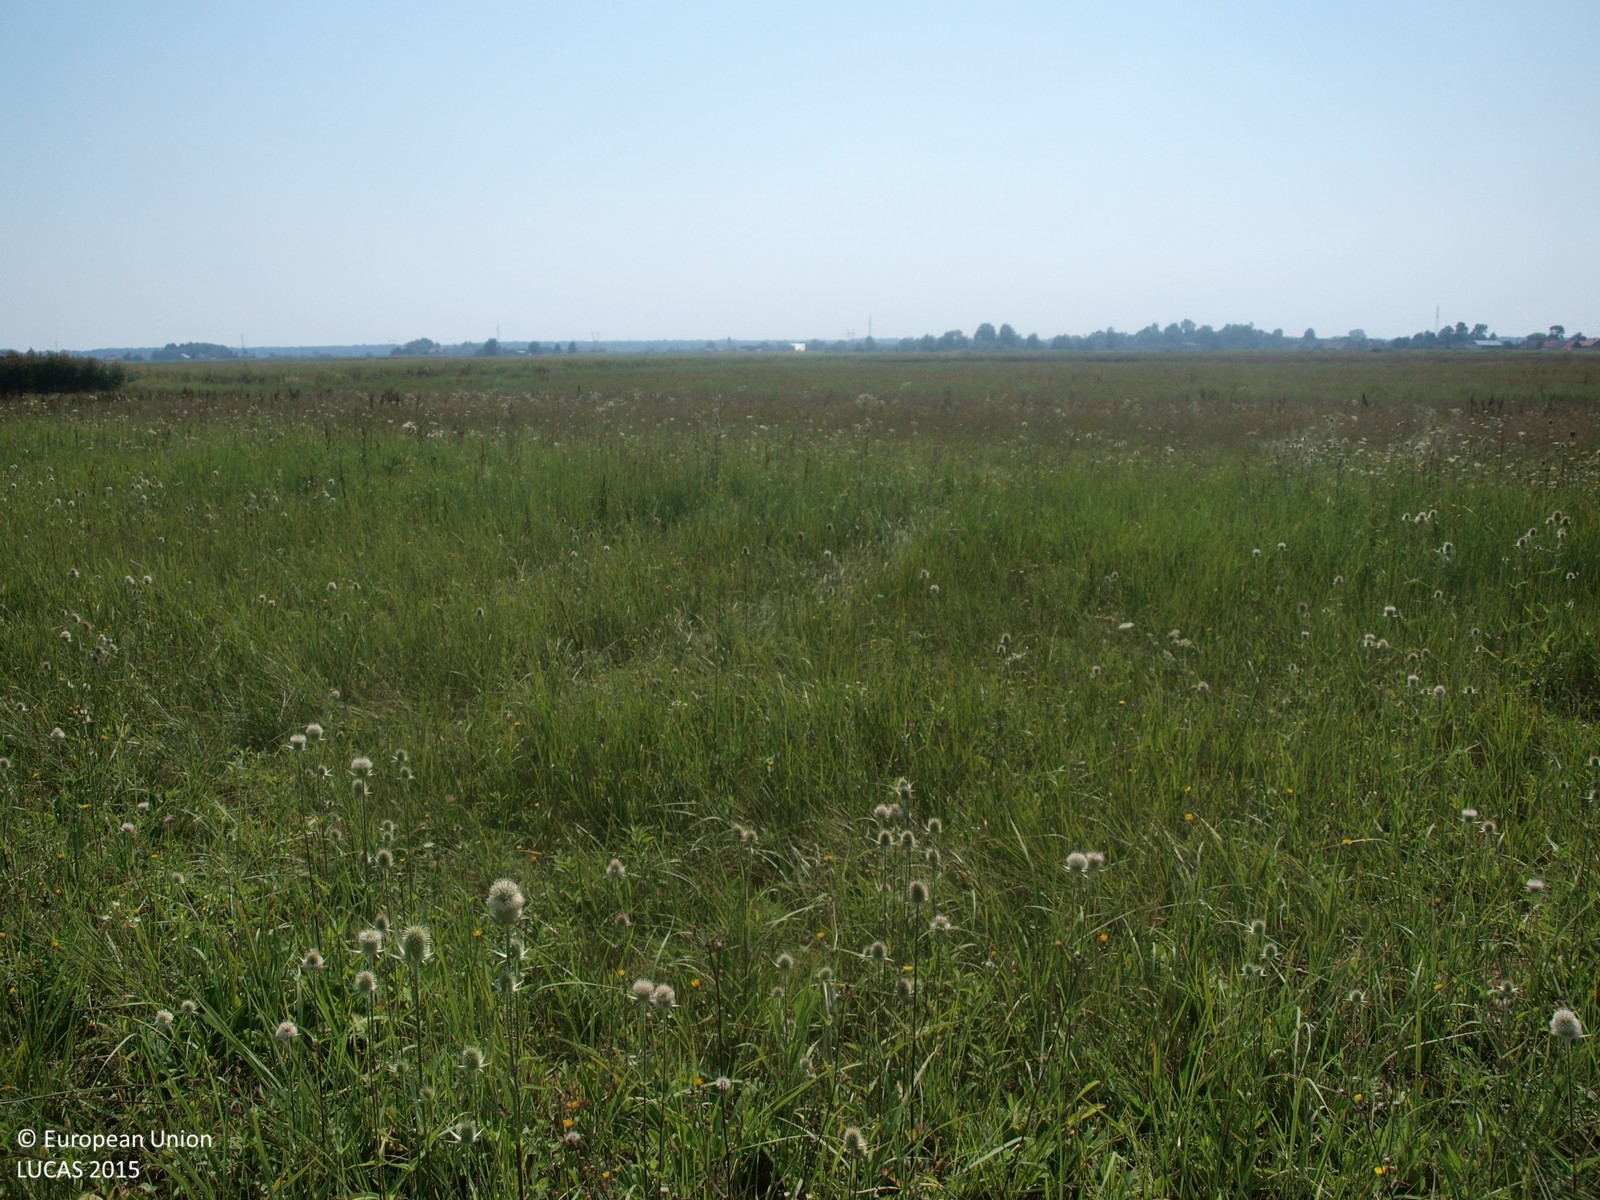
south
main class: Grassland
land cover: Grassland without tree/shrub cover
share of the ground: > 75 %
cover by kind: herbaceous plants 100 %
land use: Agriculture (excluding fallow land and kitchen gardens)
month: August
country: HR
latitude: 45.6667
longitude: 16.4806
